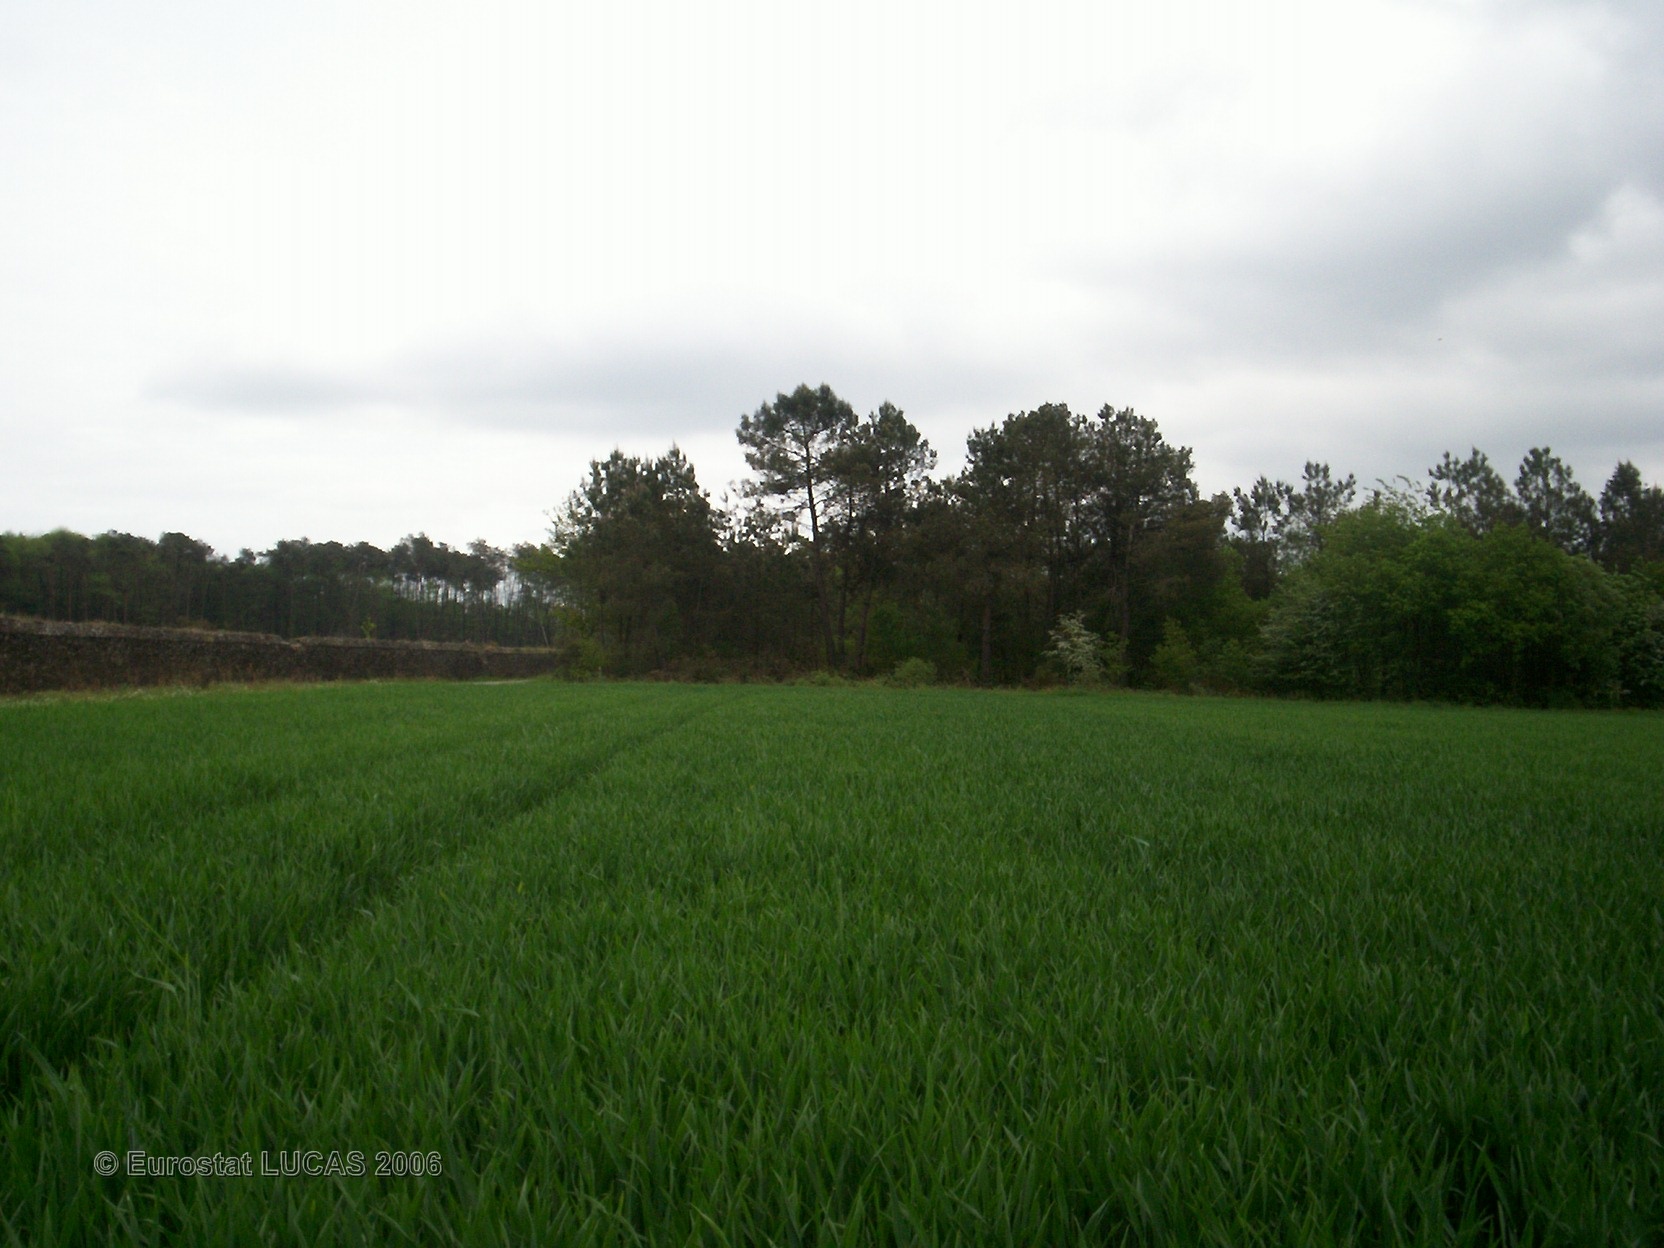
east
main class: Cropland
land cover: Common wheat
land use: Agriculture (excluding fallow land and kitchen gardens)
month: May
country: FR
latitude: 47.8815
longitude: -2.2641
